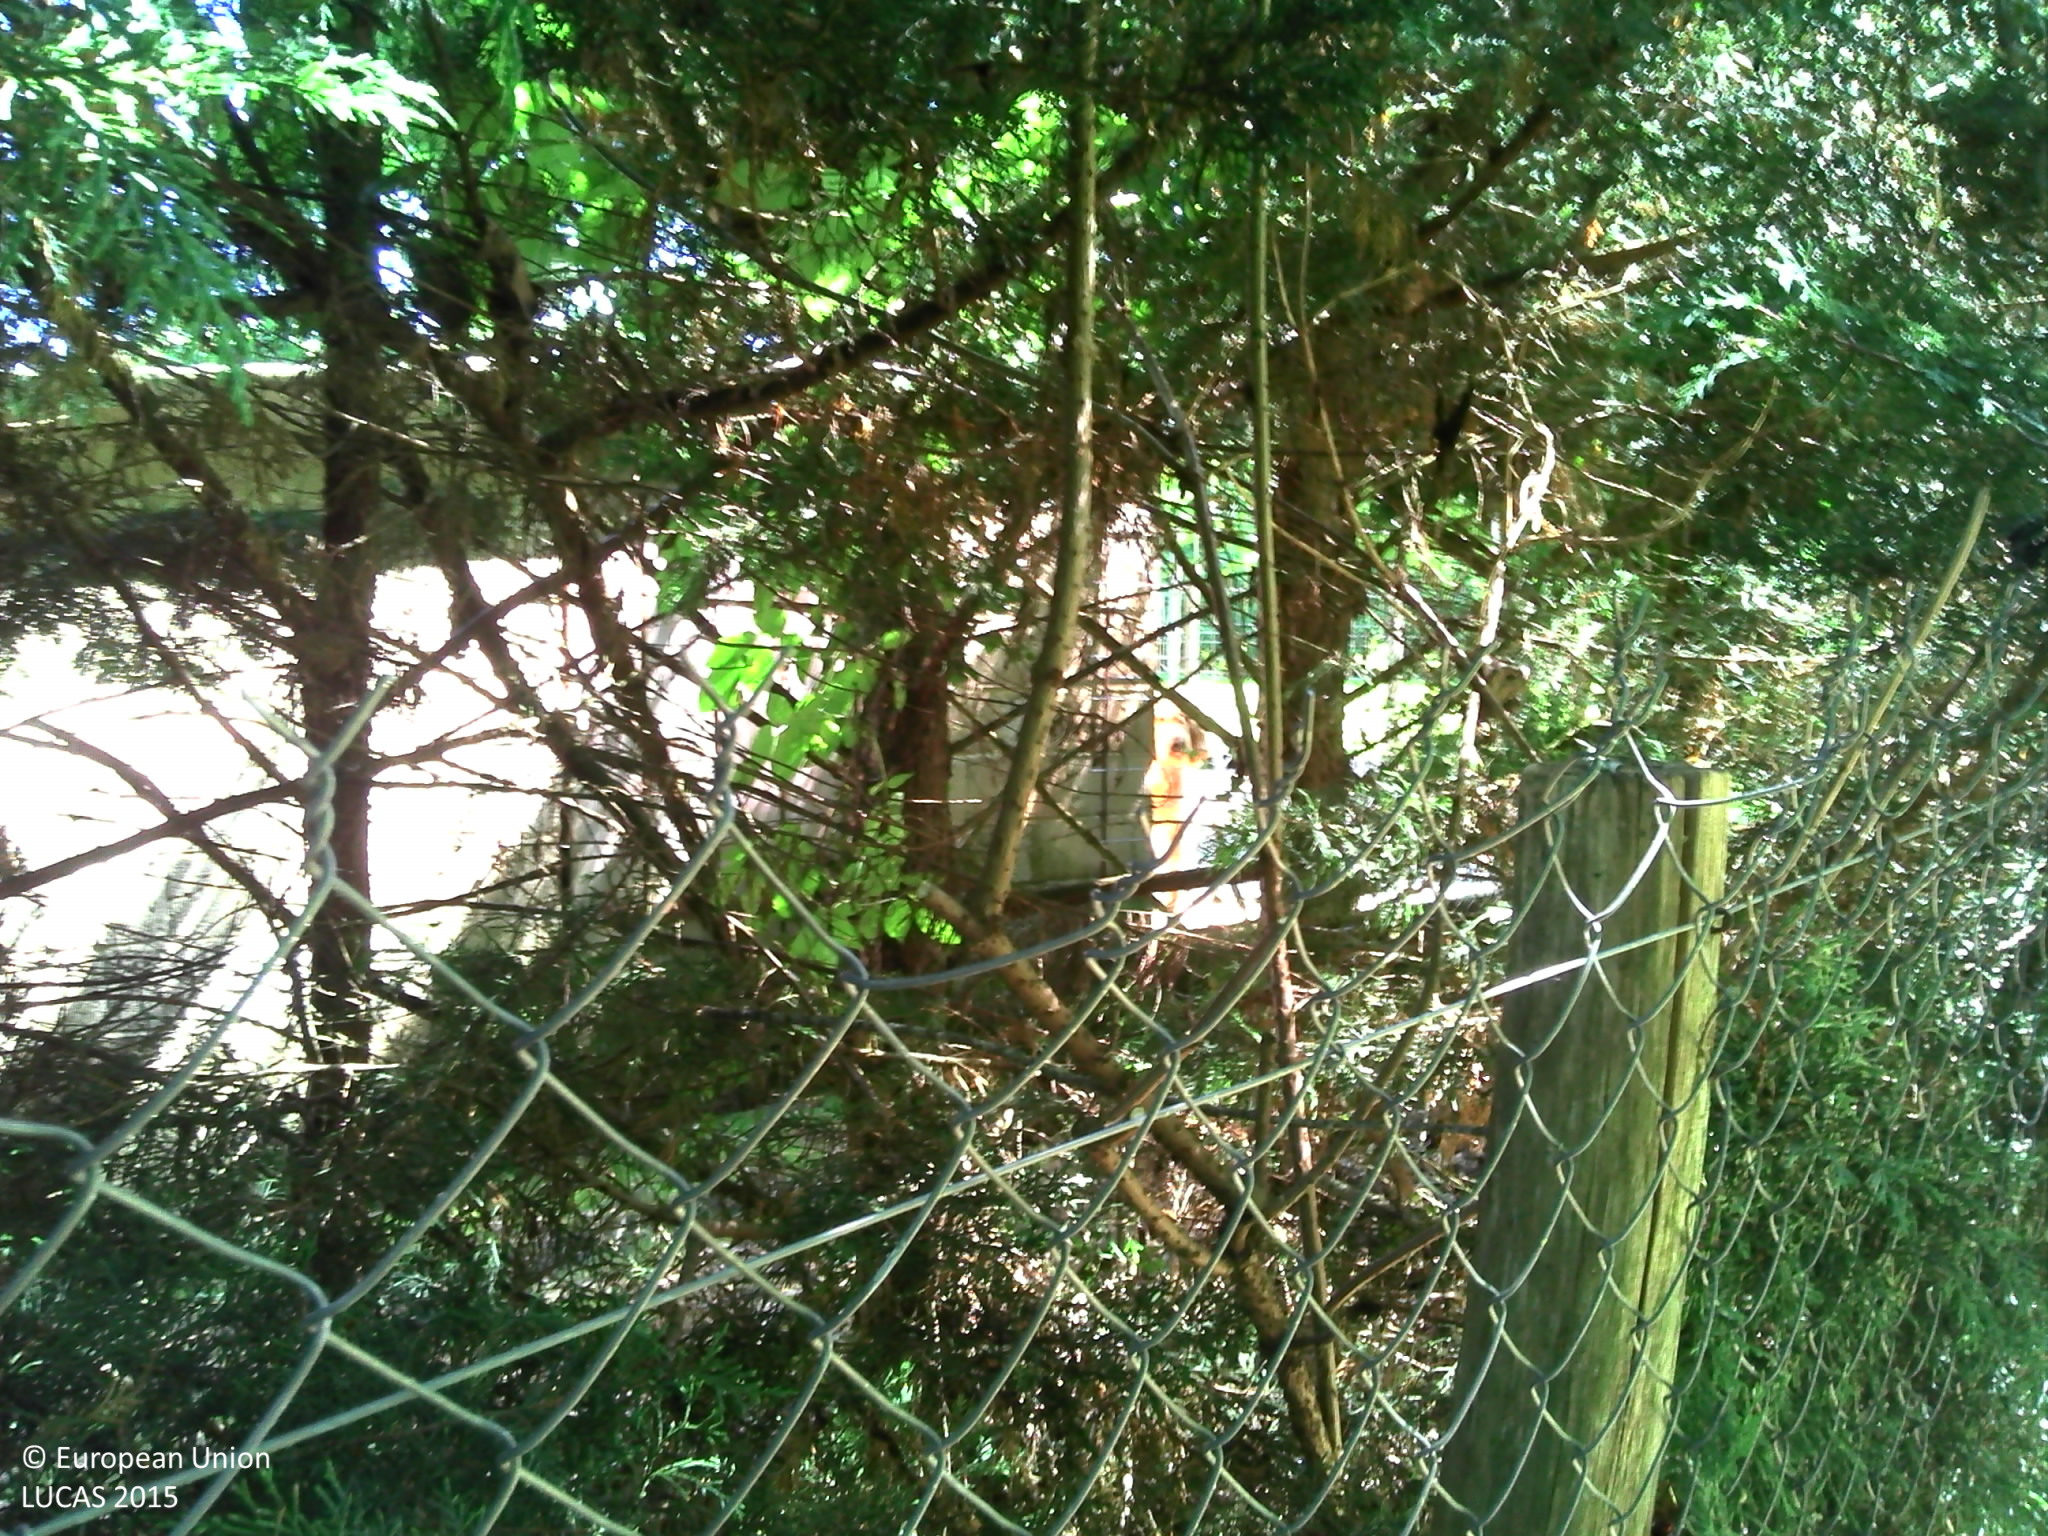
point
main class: Grassland
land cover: Grassland with sparse tree/shrub cover
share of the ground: > 75 %
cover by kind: herbaceous plants 95 %, broadleaved forest trees 5 %
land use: Residential
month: August
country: FR
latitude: 45.2584
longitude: 0.5201
